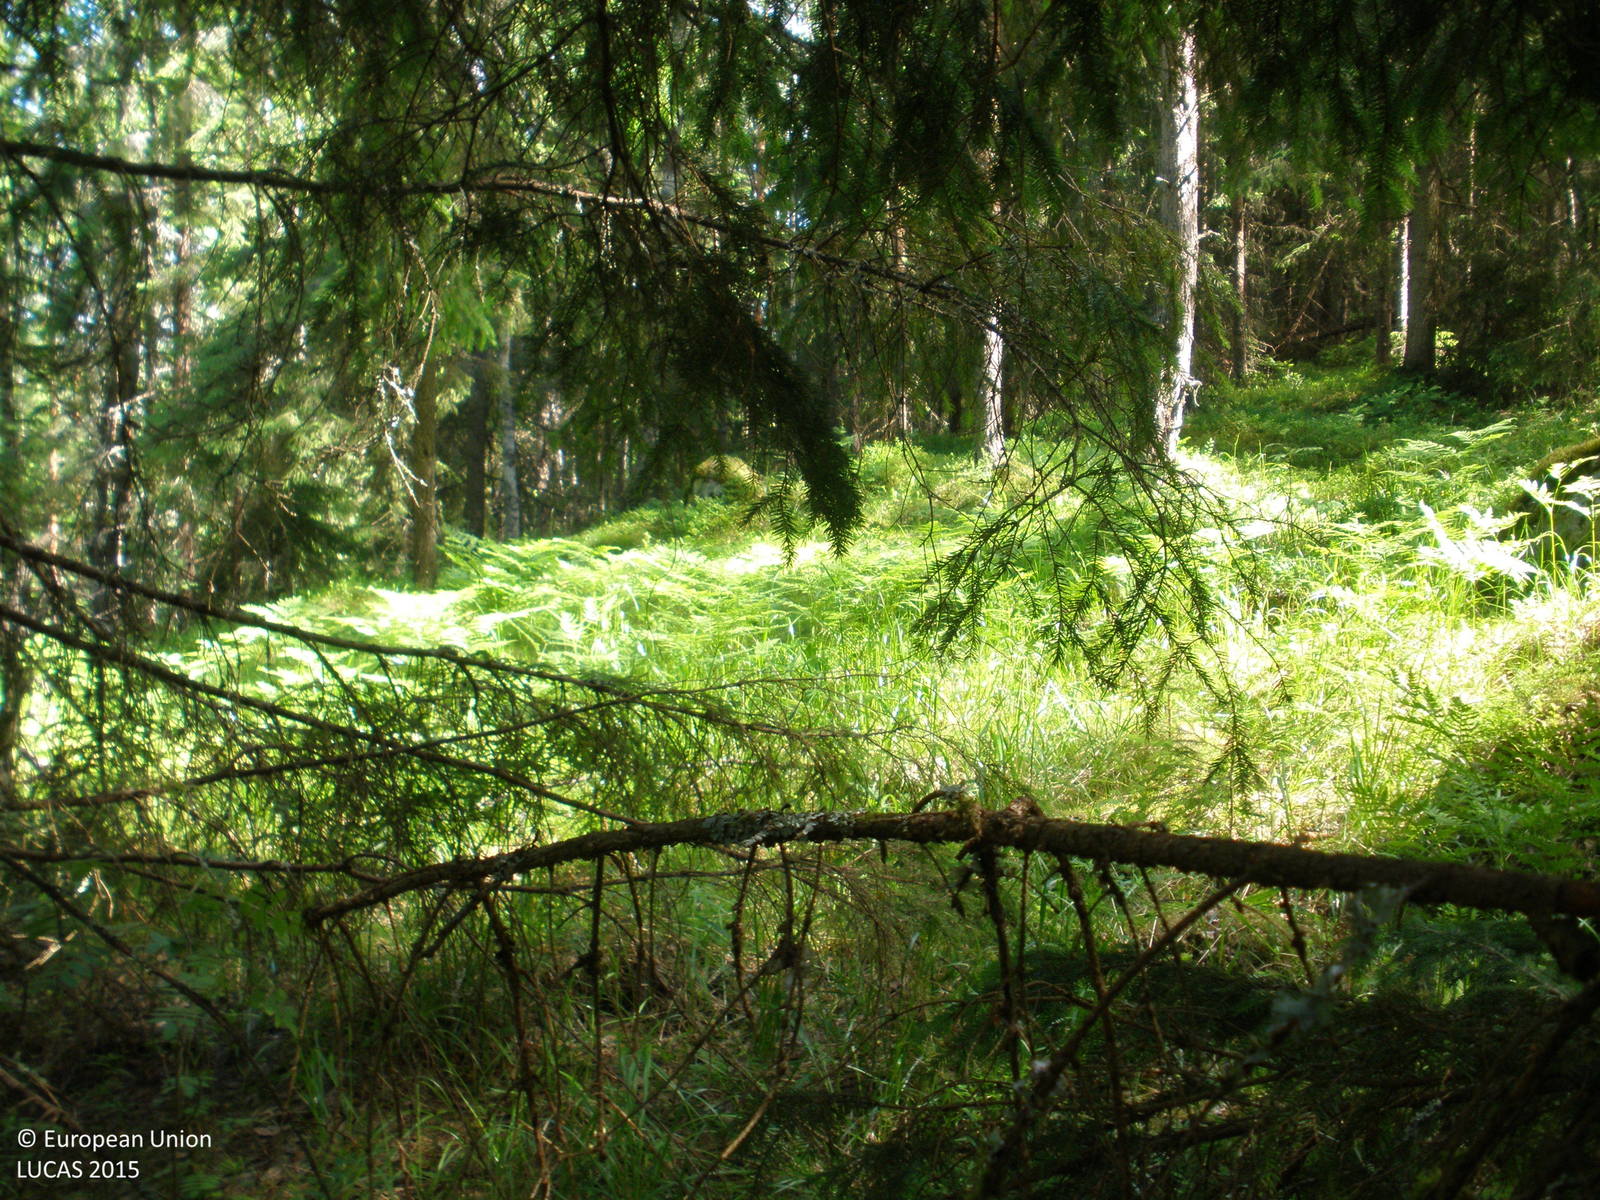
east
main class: Woodland
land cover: Pine dominated mixed woodland
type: boreal forest
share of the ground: > 75 %
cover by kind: coniferous forest trees 55 %, broadleaved forest trees 30 %, herbaceous plants 10 %, lichens and mosses 5 %
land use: Forestry
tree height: > 5 m
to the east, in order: Pine dominated mixed woodland; Spruce dominated mixed woodland; Other mixed woodland; Ditches and canals; Other bare soil; Ditches and canals; Other bare soil; Spruce dominated coniferous woodland
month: June
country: FI
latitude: 61.0240
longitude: 24.6693
